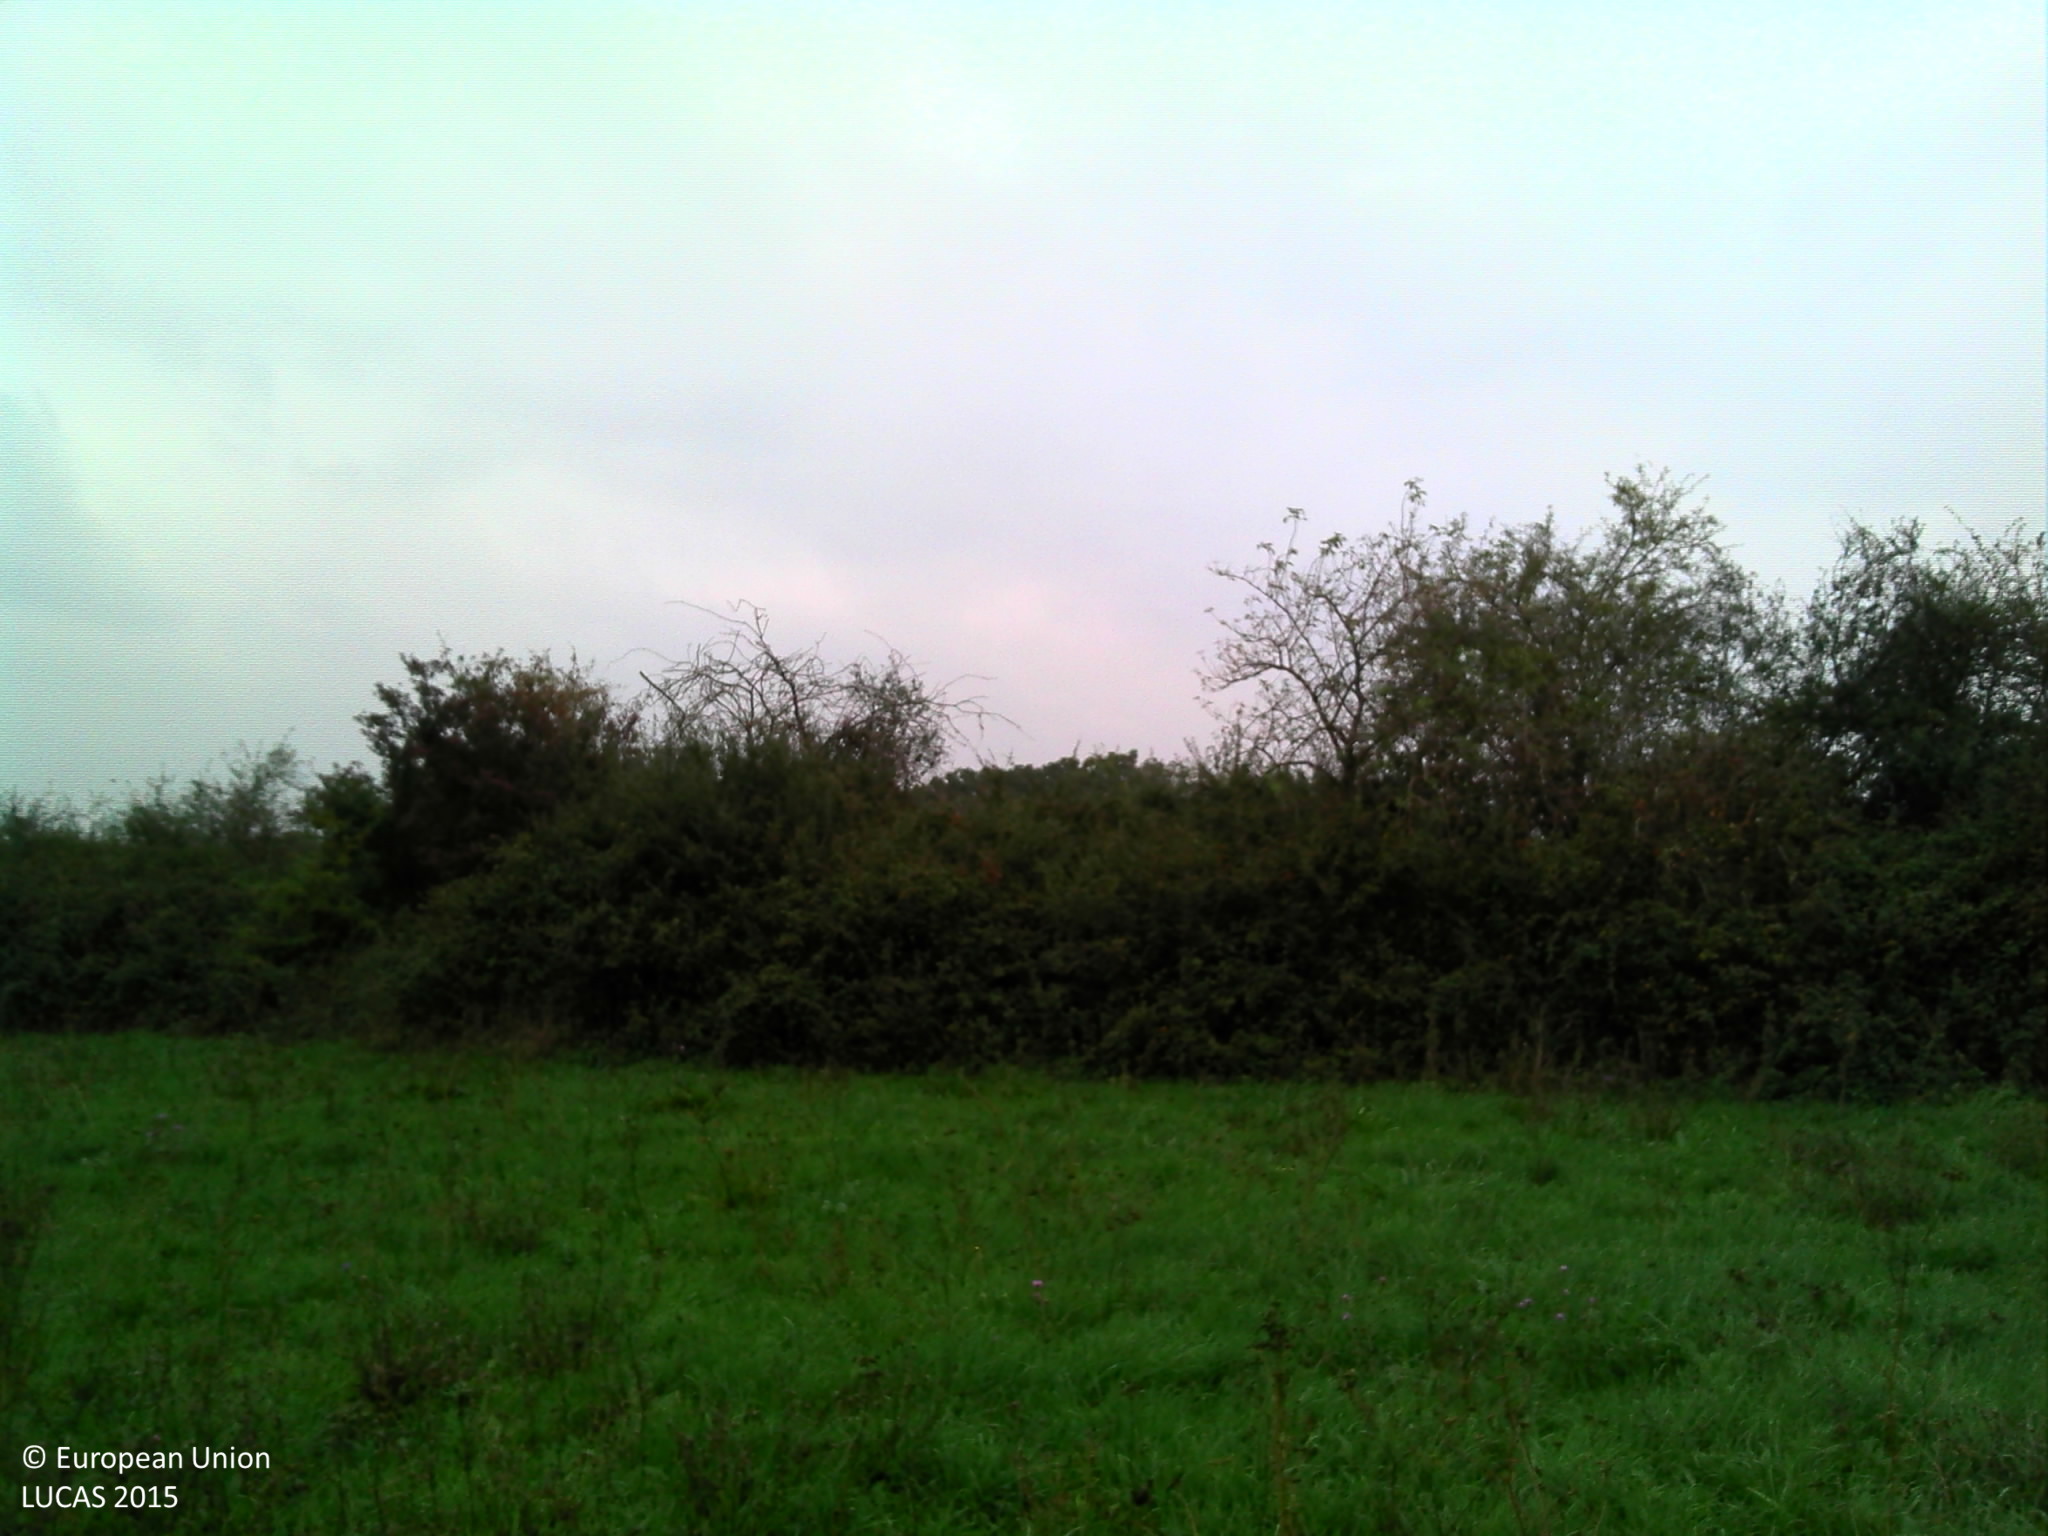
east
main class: Grassland
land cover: Grassland without tree/shrub cover
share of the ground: > 75 %
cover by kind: herbaceous plants 100 %
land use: Agriculture (excluding fallow land and kitchen gardens)
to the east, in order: Grassland without tree/shrub cover; Abandoned hedges; Grass margins; Tracks; Grass margins; Ditches and canals; Grass margins; Common wheat; Grassland without tree/shrub cover; Broadleaved woodland; Grassland without tree/shrub cover
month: October
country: FR
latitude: 46.2564
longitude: 5.0862
